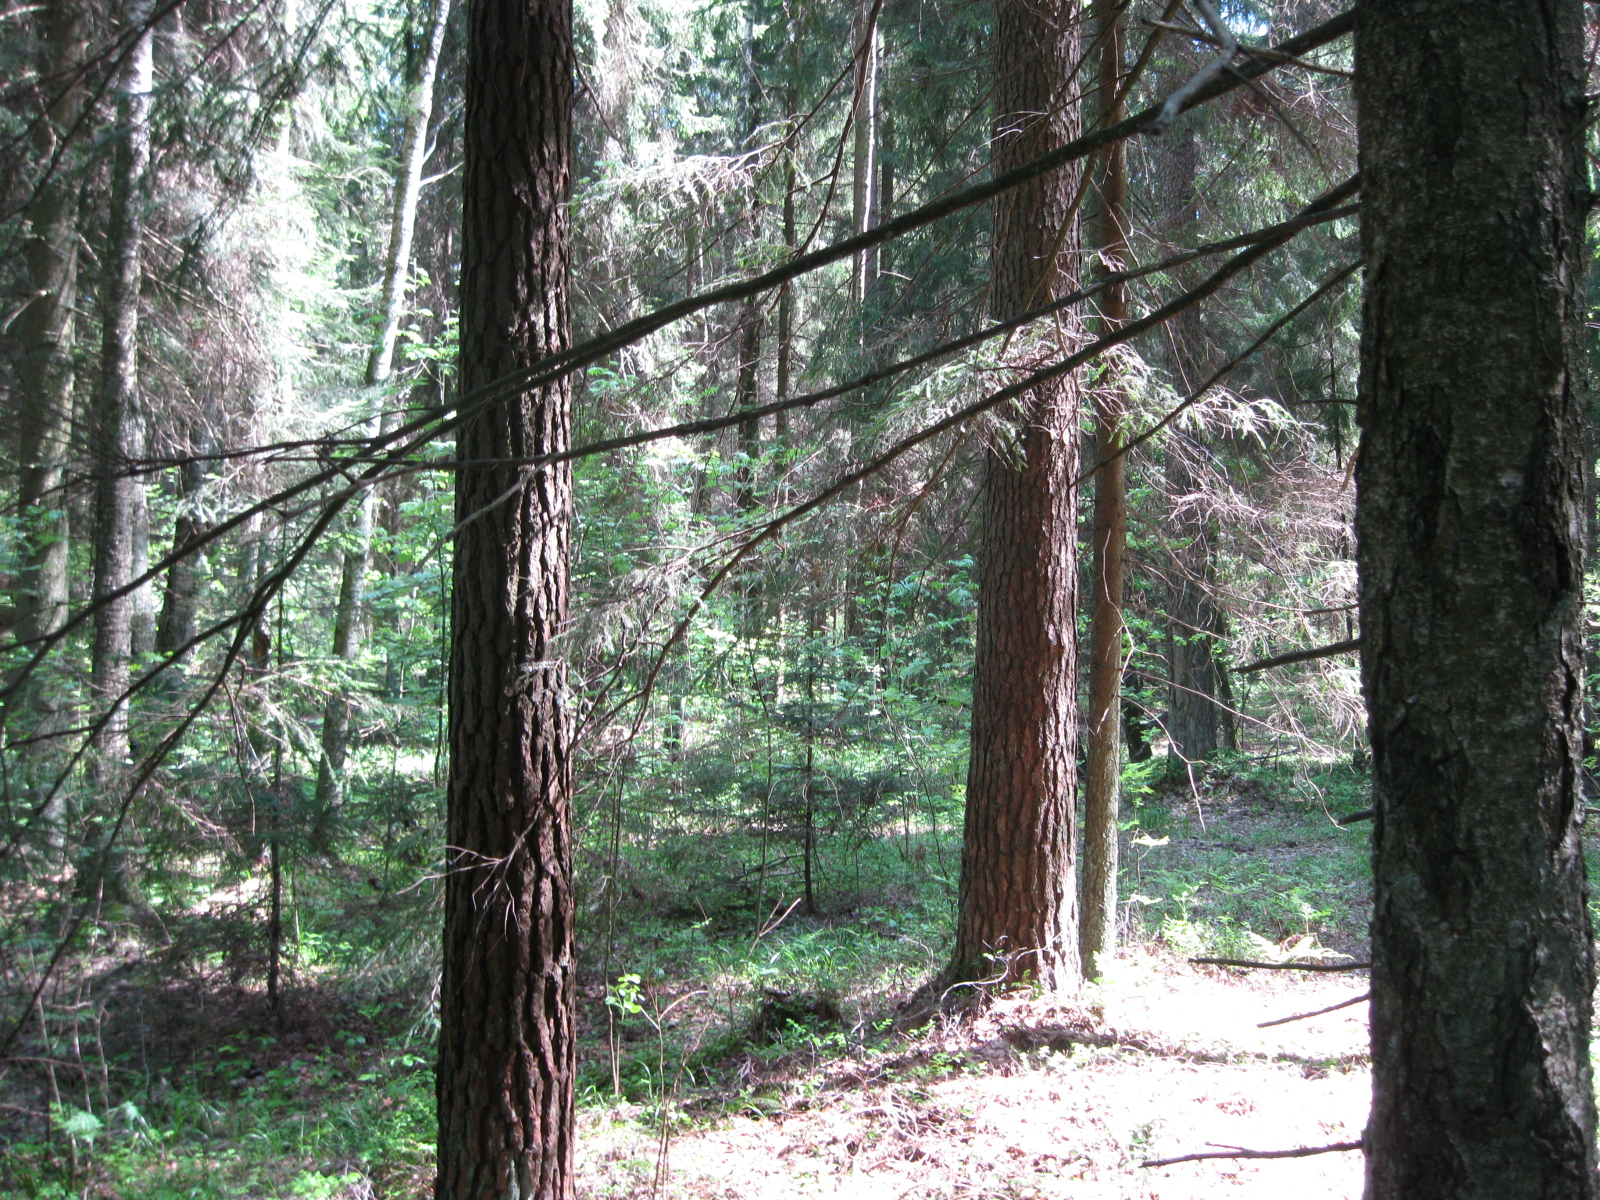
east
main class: Woodland
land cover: Spruce dominated mixed woodland
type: hemiboreal forest and nemoral coniferous forest and mixed broadleaved-coniferous forest
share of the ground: > 75 %
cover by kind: coniferous forest trees 50 %, broadleaved forest trees 45 %, lichens and mosses 5 %
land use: Forestry
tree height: > 5 m
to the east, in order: Spruce dominated mixed woodland; Tracks; Spruce dominated mixed woodland
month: May
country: LT
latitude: 56.0047
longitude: 24.1219
